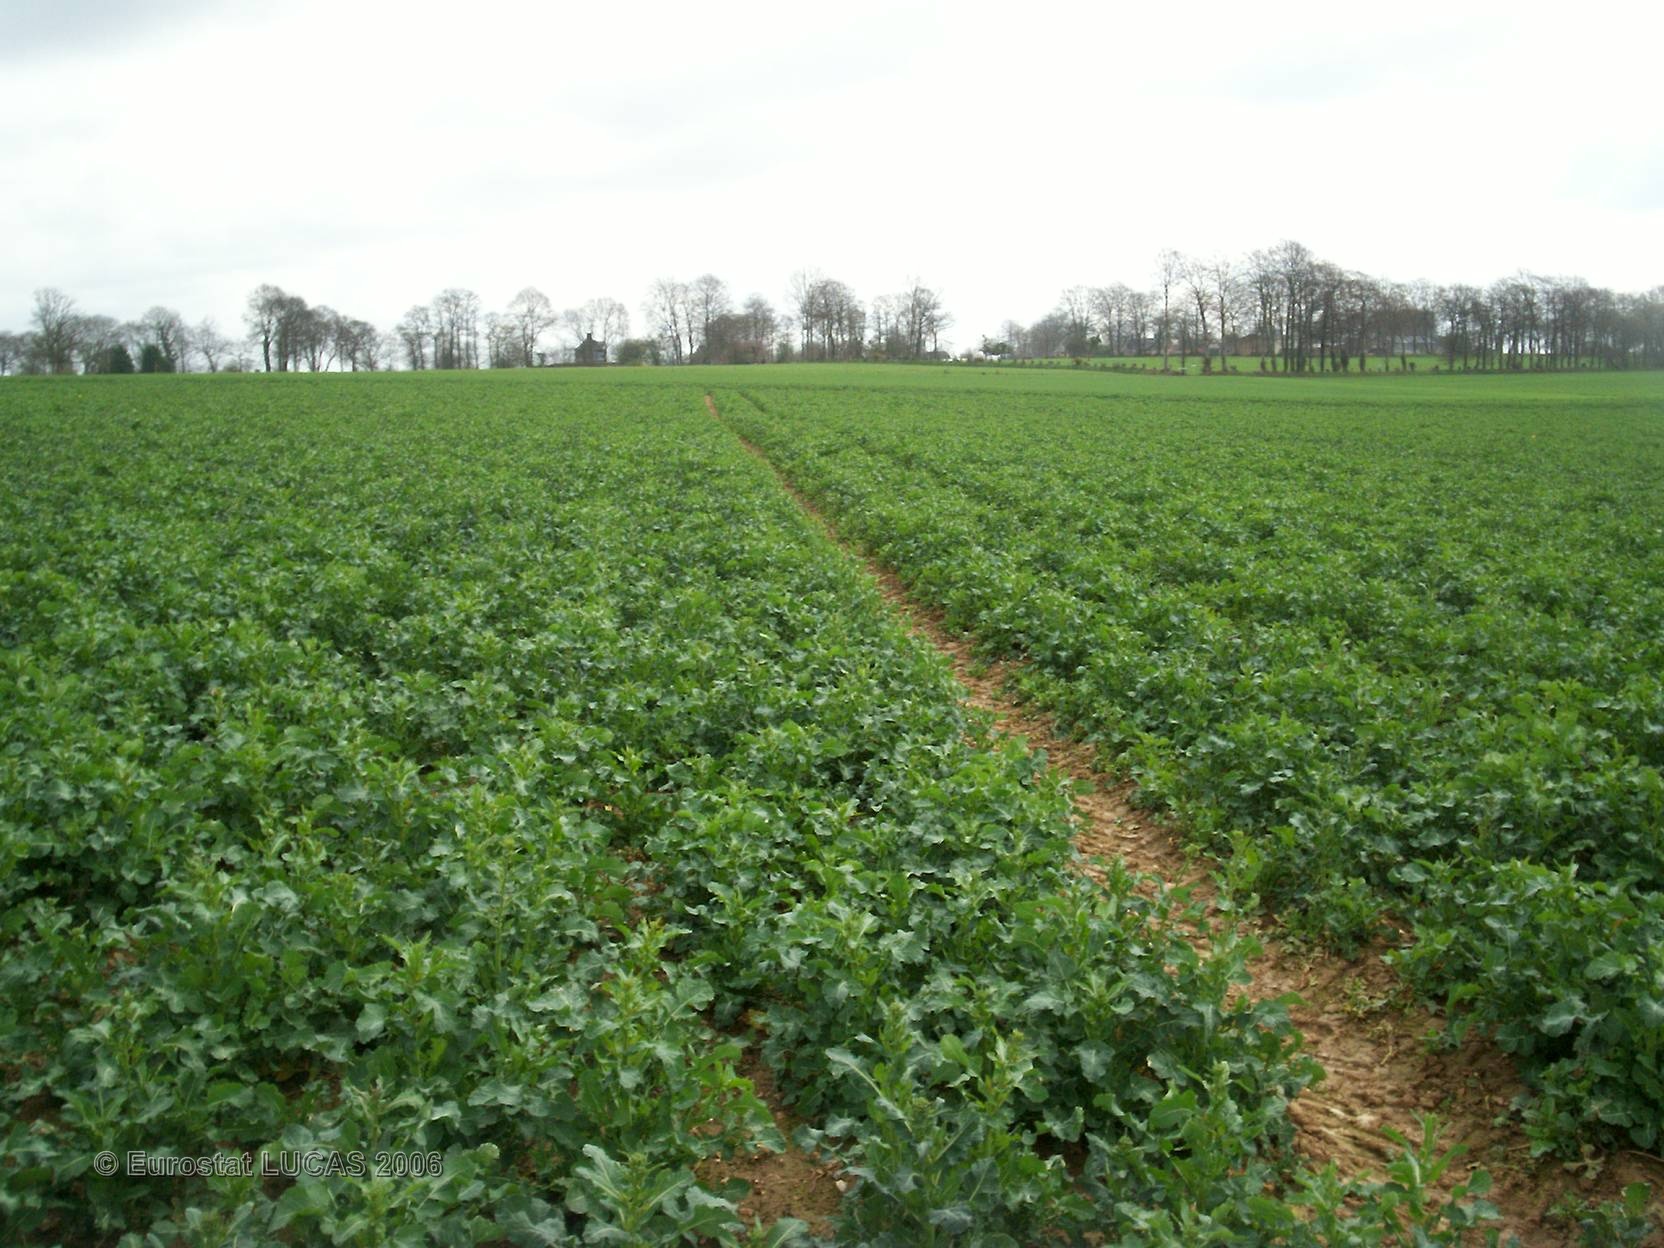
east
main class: Cropland
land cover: Rape and turnip rape
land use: Agriculture (excluding fallow land and kitchen gardens)
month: April
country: FR
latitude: 49.7284
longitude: 0.8898
